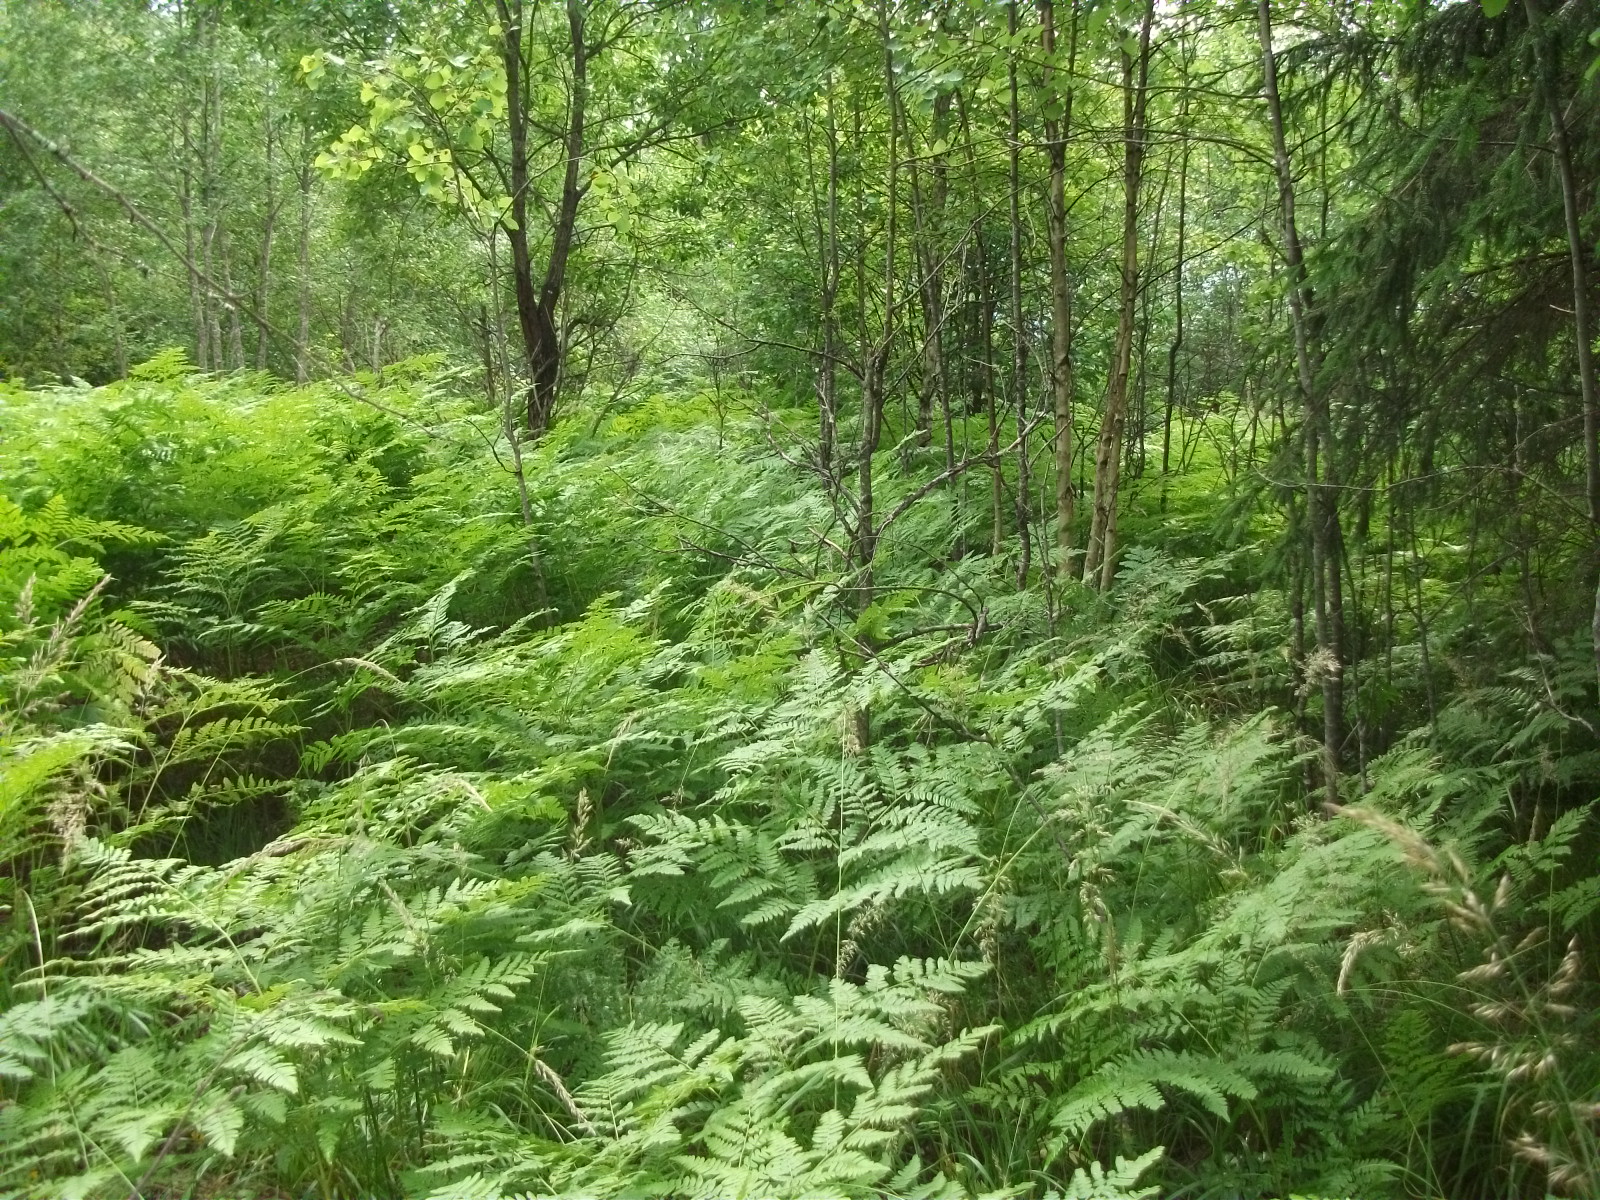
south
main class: Woodland
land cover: Spruce dominated mixed woodland
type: hemiboreal forest and nemoral coniferous forest and mixed broadleaved-coniferous forest
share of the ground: 50 - 75 %
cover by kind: coniferous forest trees 50 %, broadleaved forest trees 20 %, shrubs 15 %, herbaceous plants 15 %
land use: Forestry
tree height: > 5 m
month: July
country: LV
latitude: 56.9205
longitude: 25.8486
